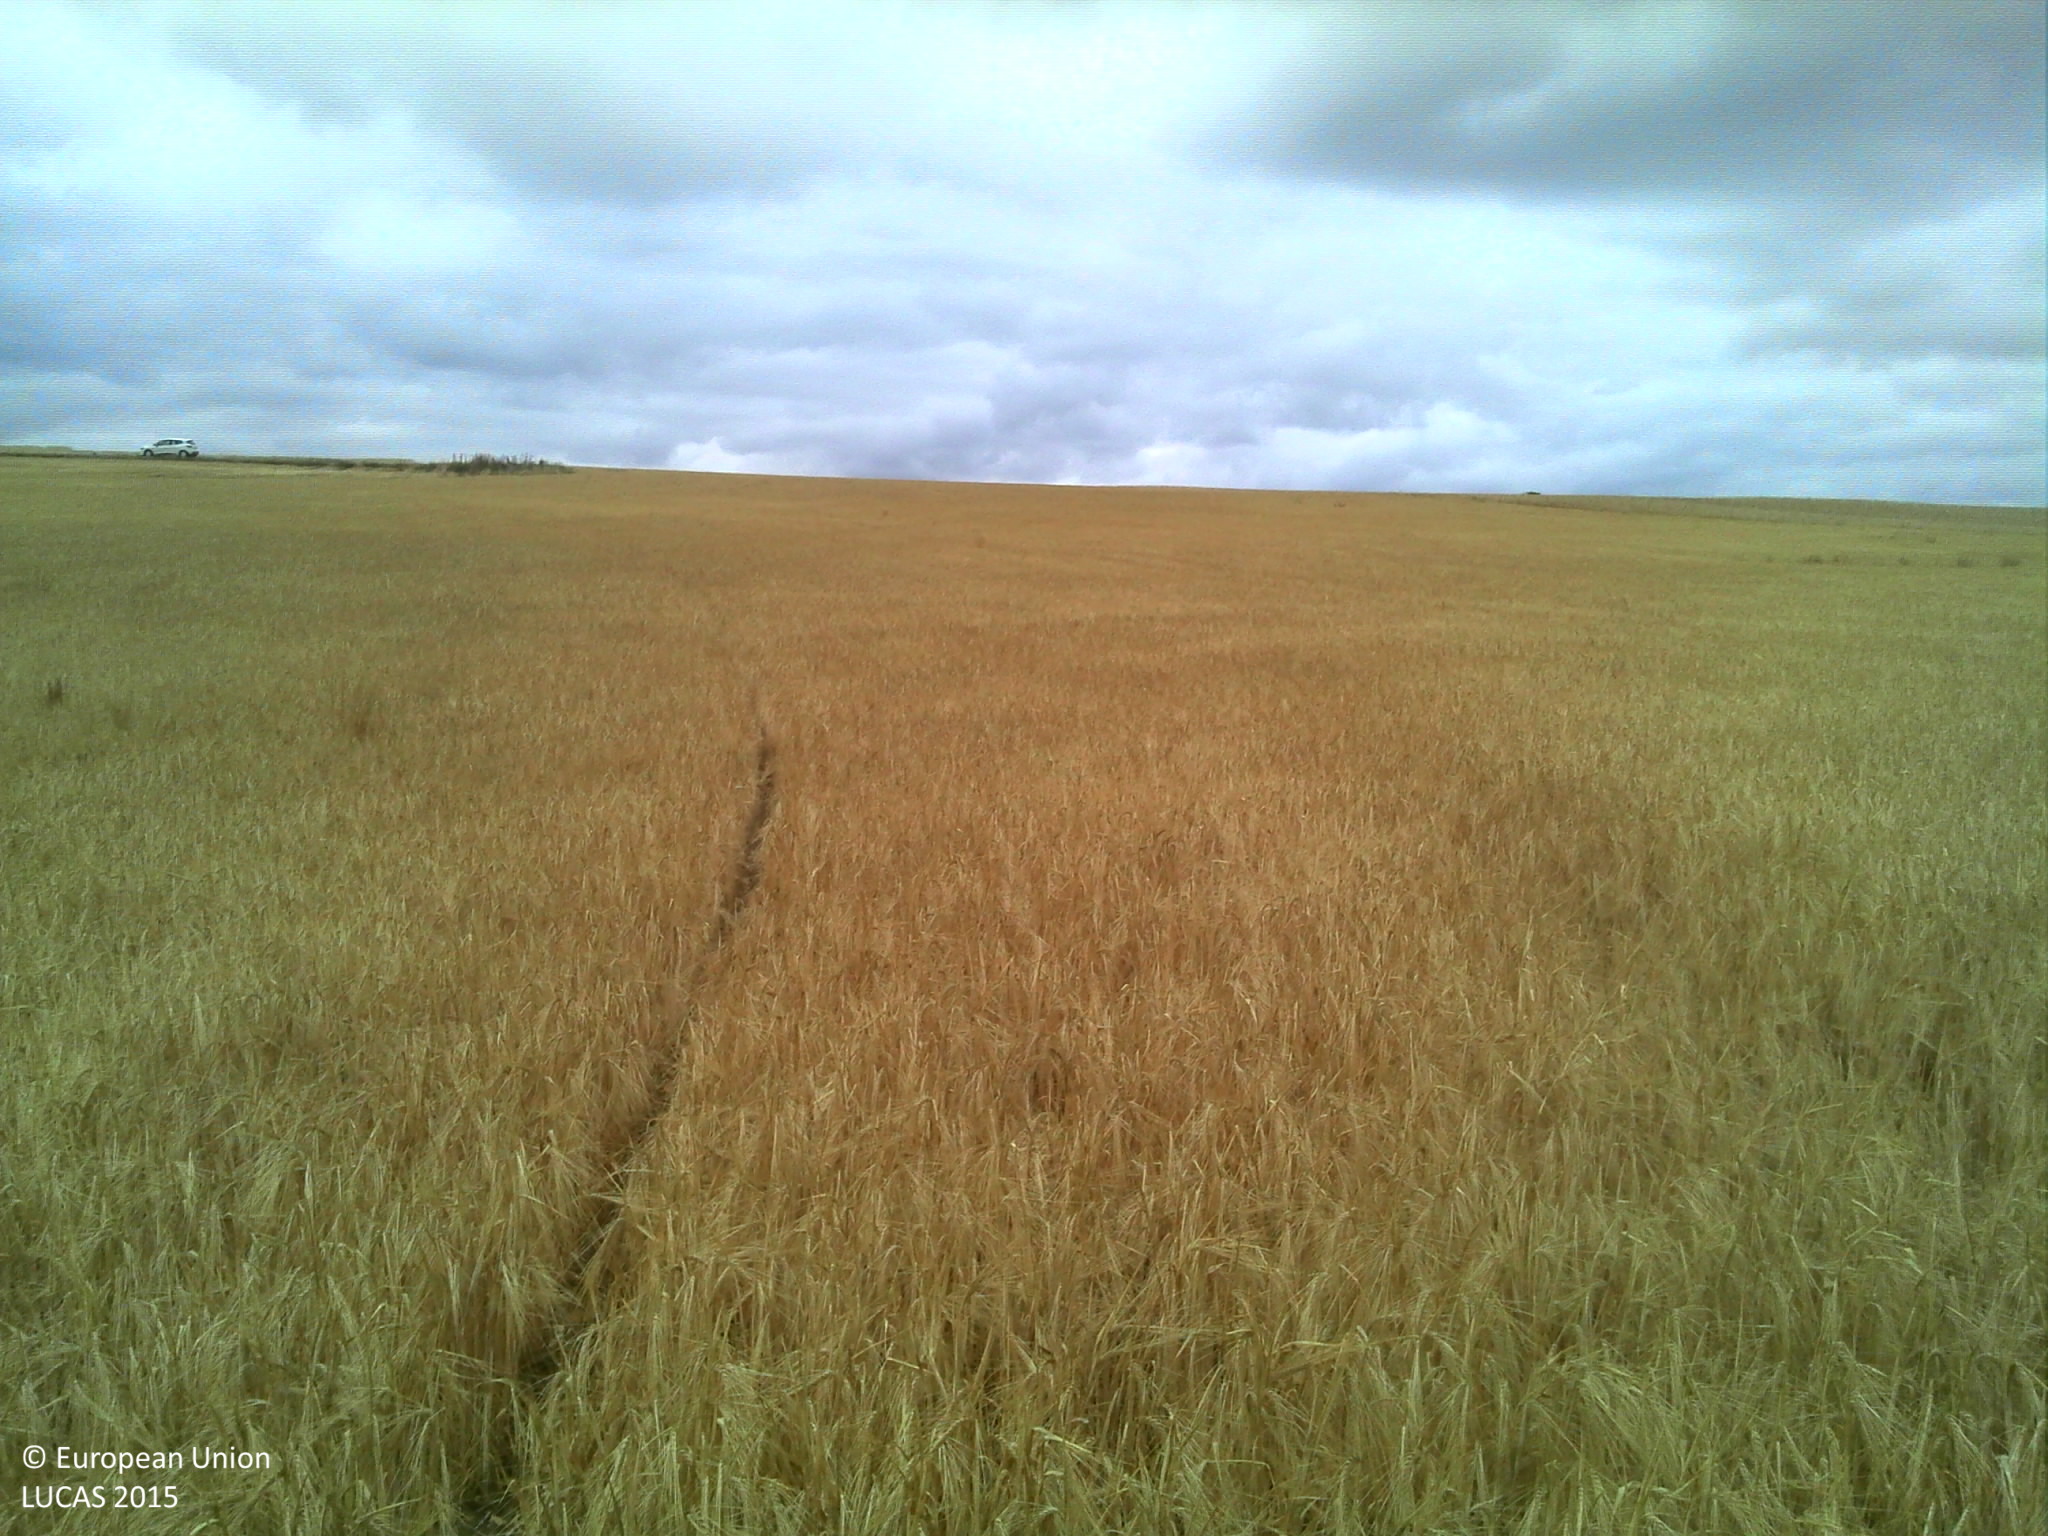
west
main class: Cropland
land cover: Barley
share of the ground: > 75 %
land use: Agriculture (excluding fallow land and kitchen gardens)
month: July
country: FR
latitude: 48.1892
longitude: 3.4163
